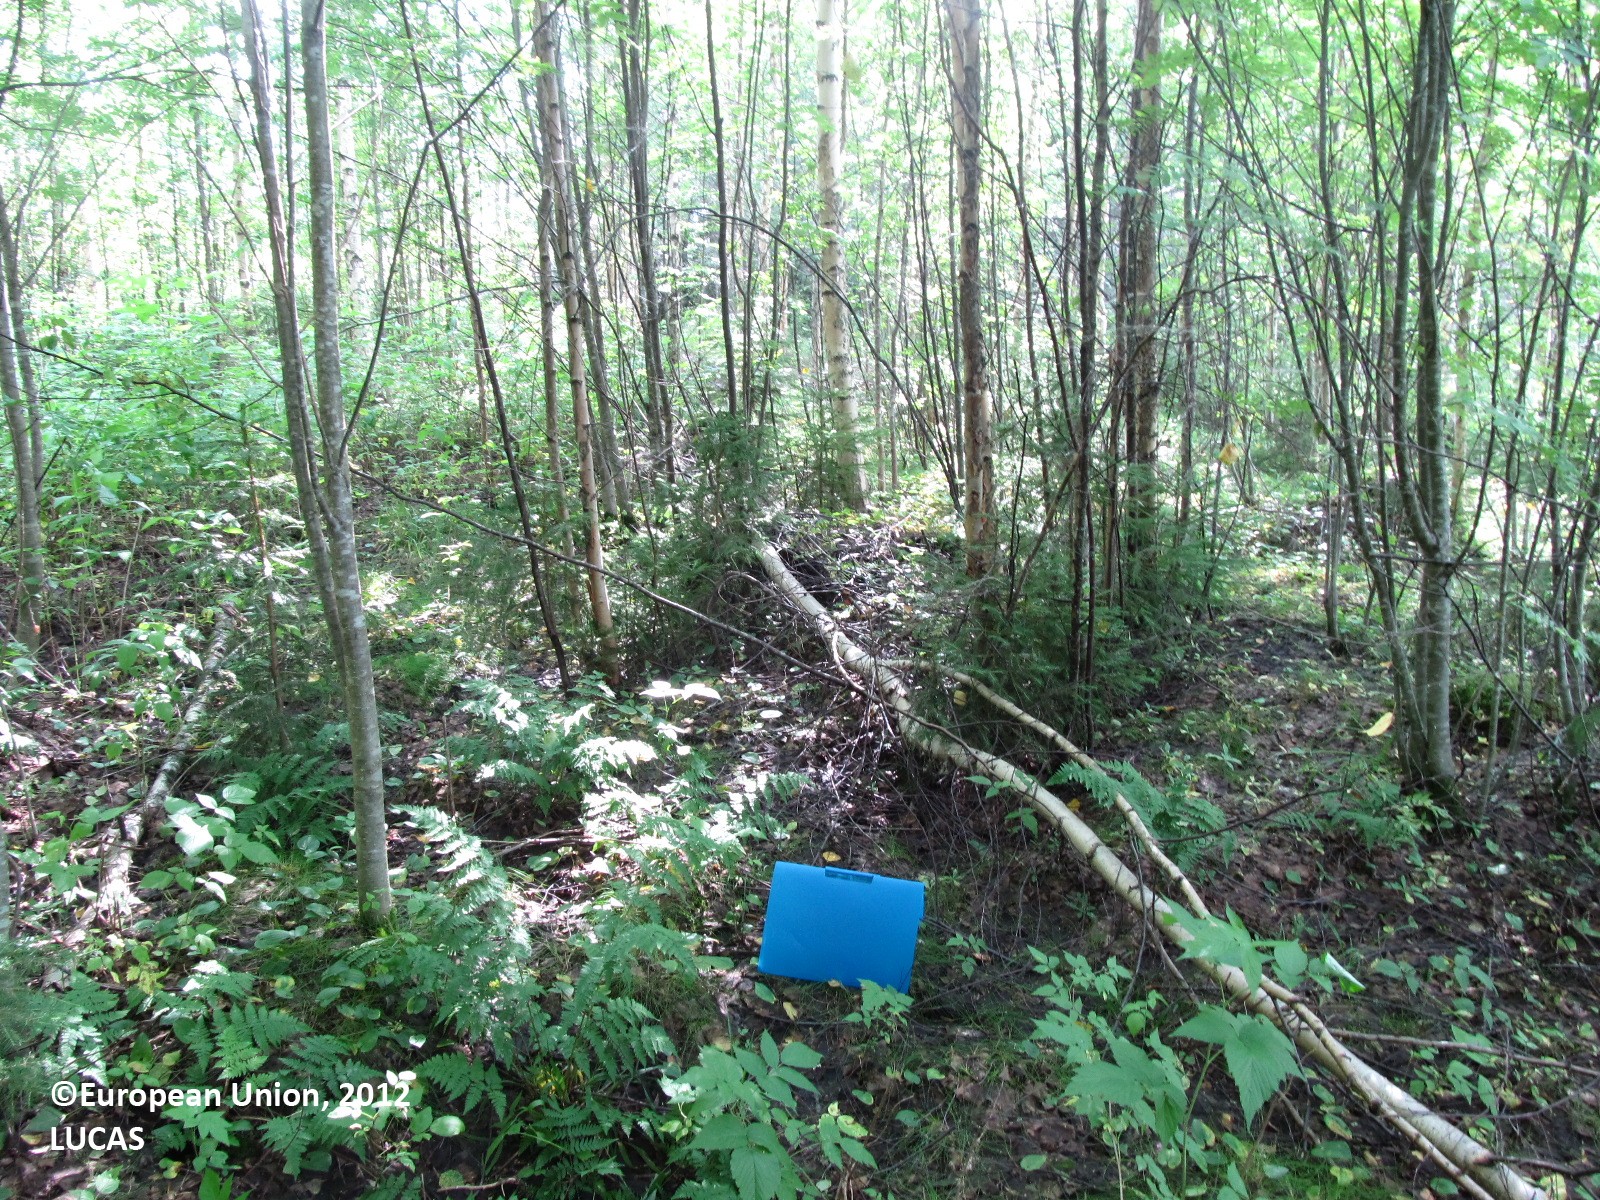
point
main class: Woodland
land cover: Broadleaved woodland
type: boreal forest
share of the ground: 25 - 50 %
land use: Forestry
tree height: > 5 m
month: July
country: FI
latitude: 62.0558
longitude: 28.1162
